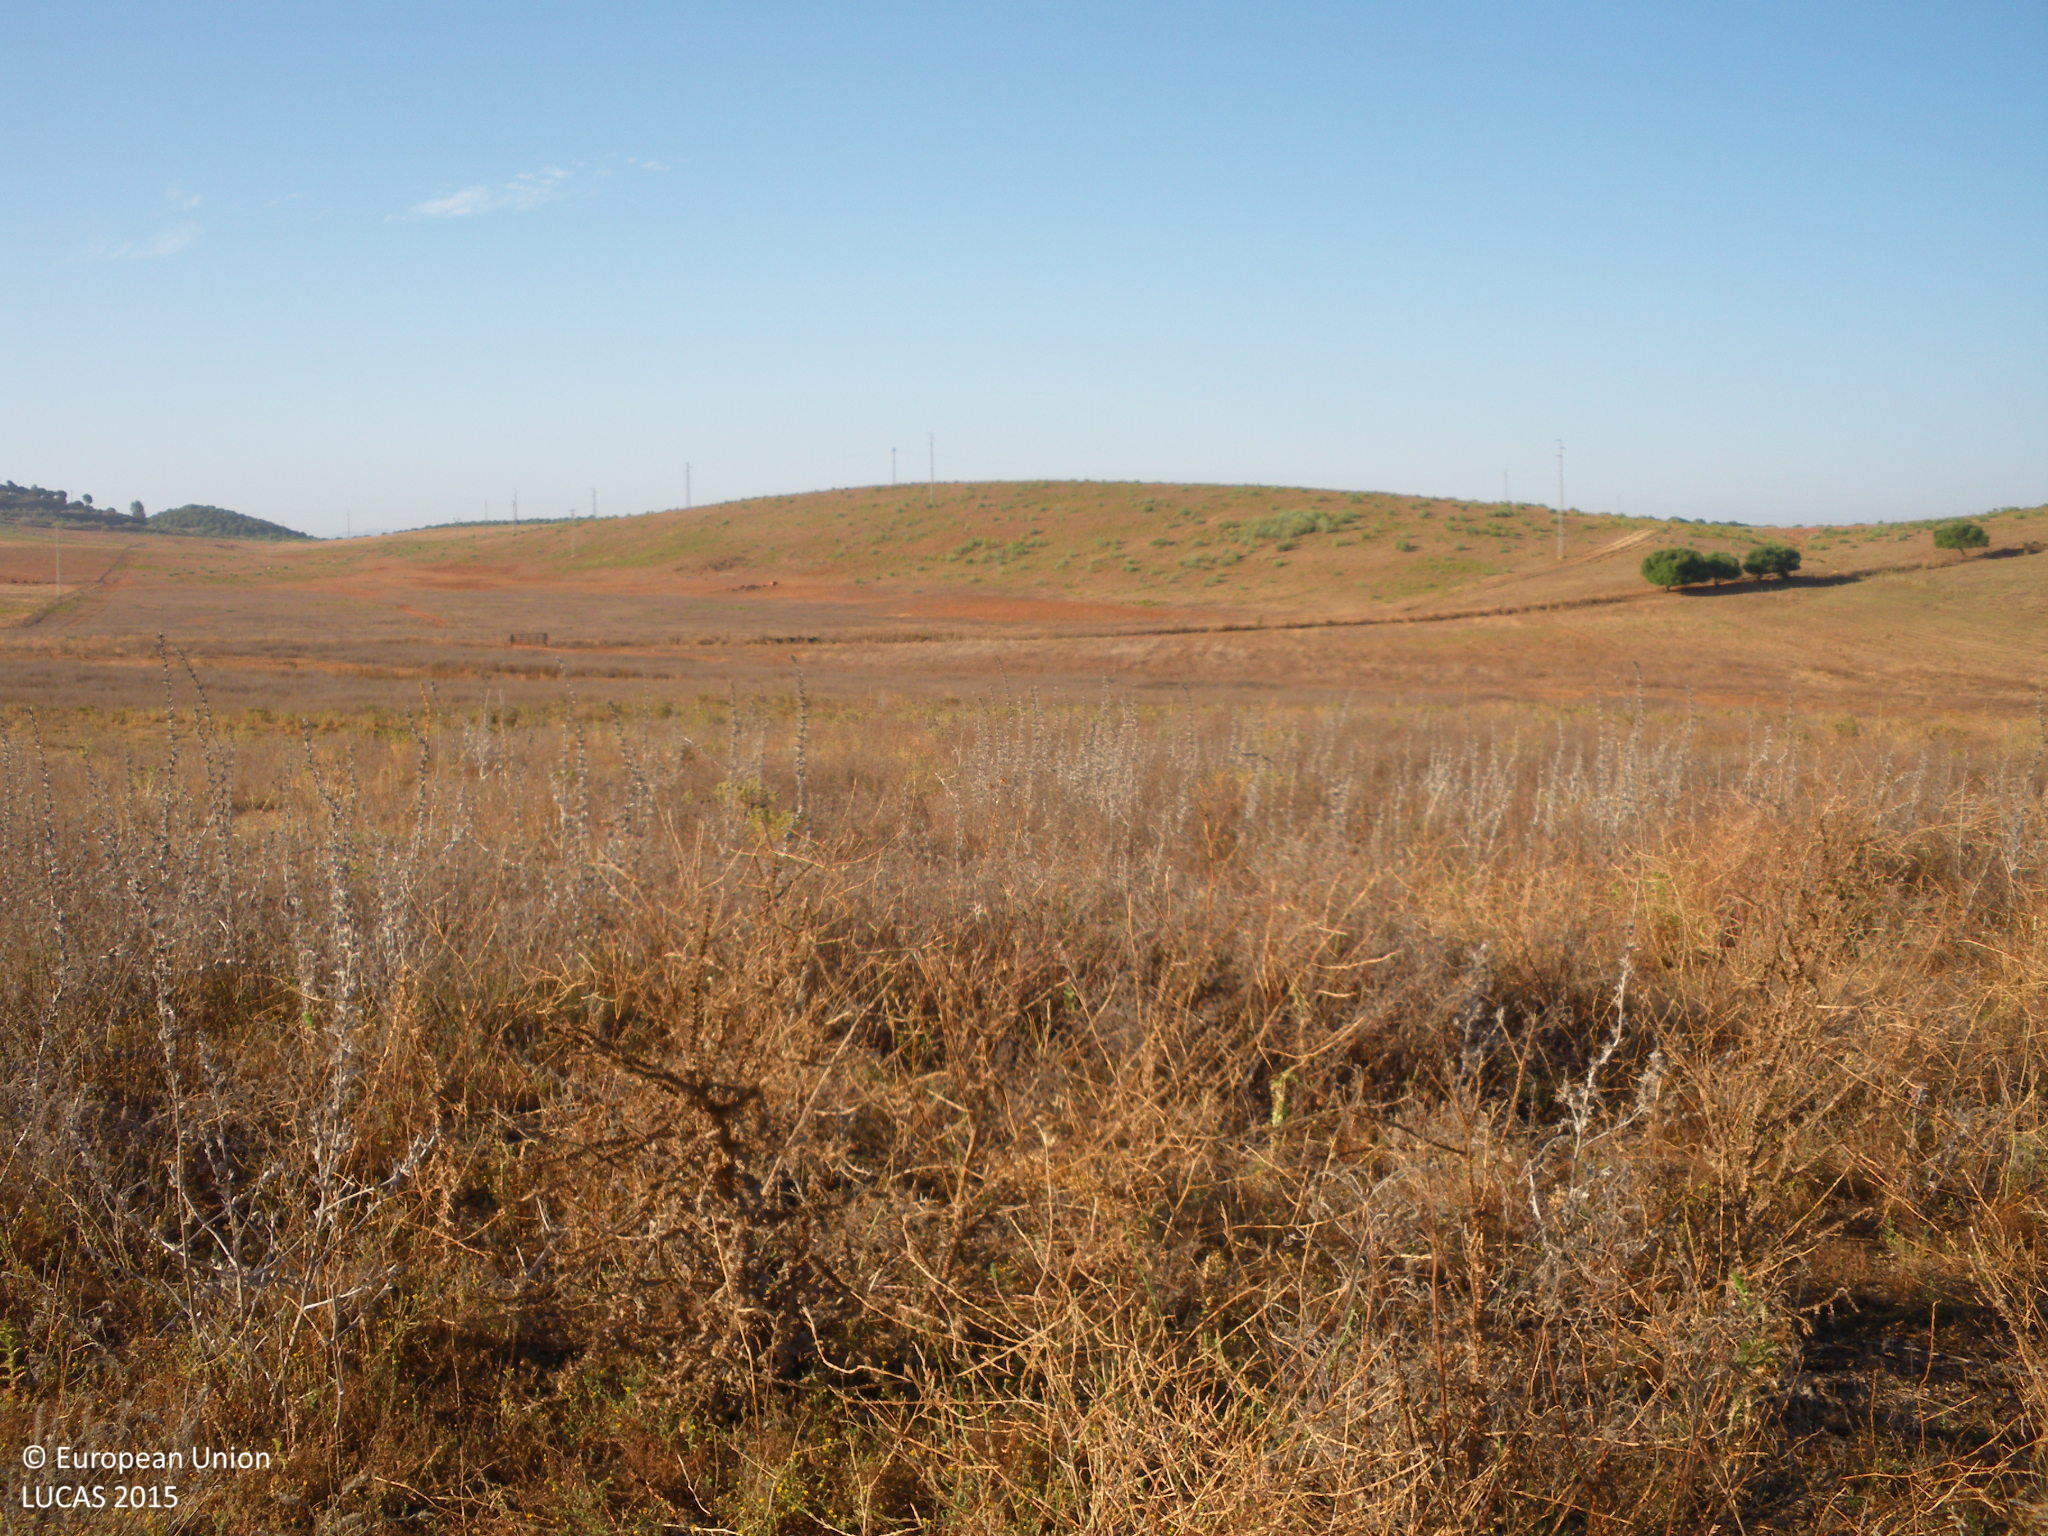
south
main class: Grassland
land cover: Grassland without tree/shrub cover
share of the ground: > 75 %
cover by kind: herbaceous plants 95 %, unconsolidated bare surface 5 %
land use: Agriculture (excluding fallow land and kitchen gardens)
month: June
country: ES
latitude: 36.8296
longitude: -5.7622
